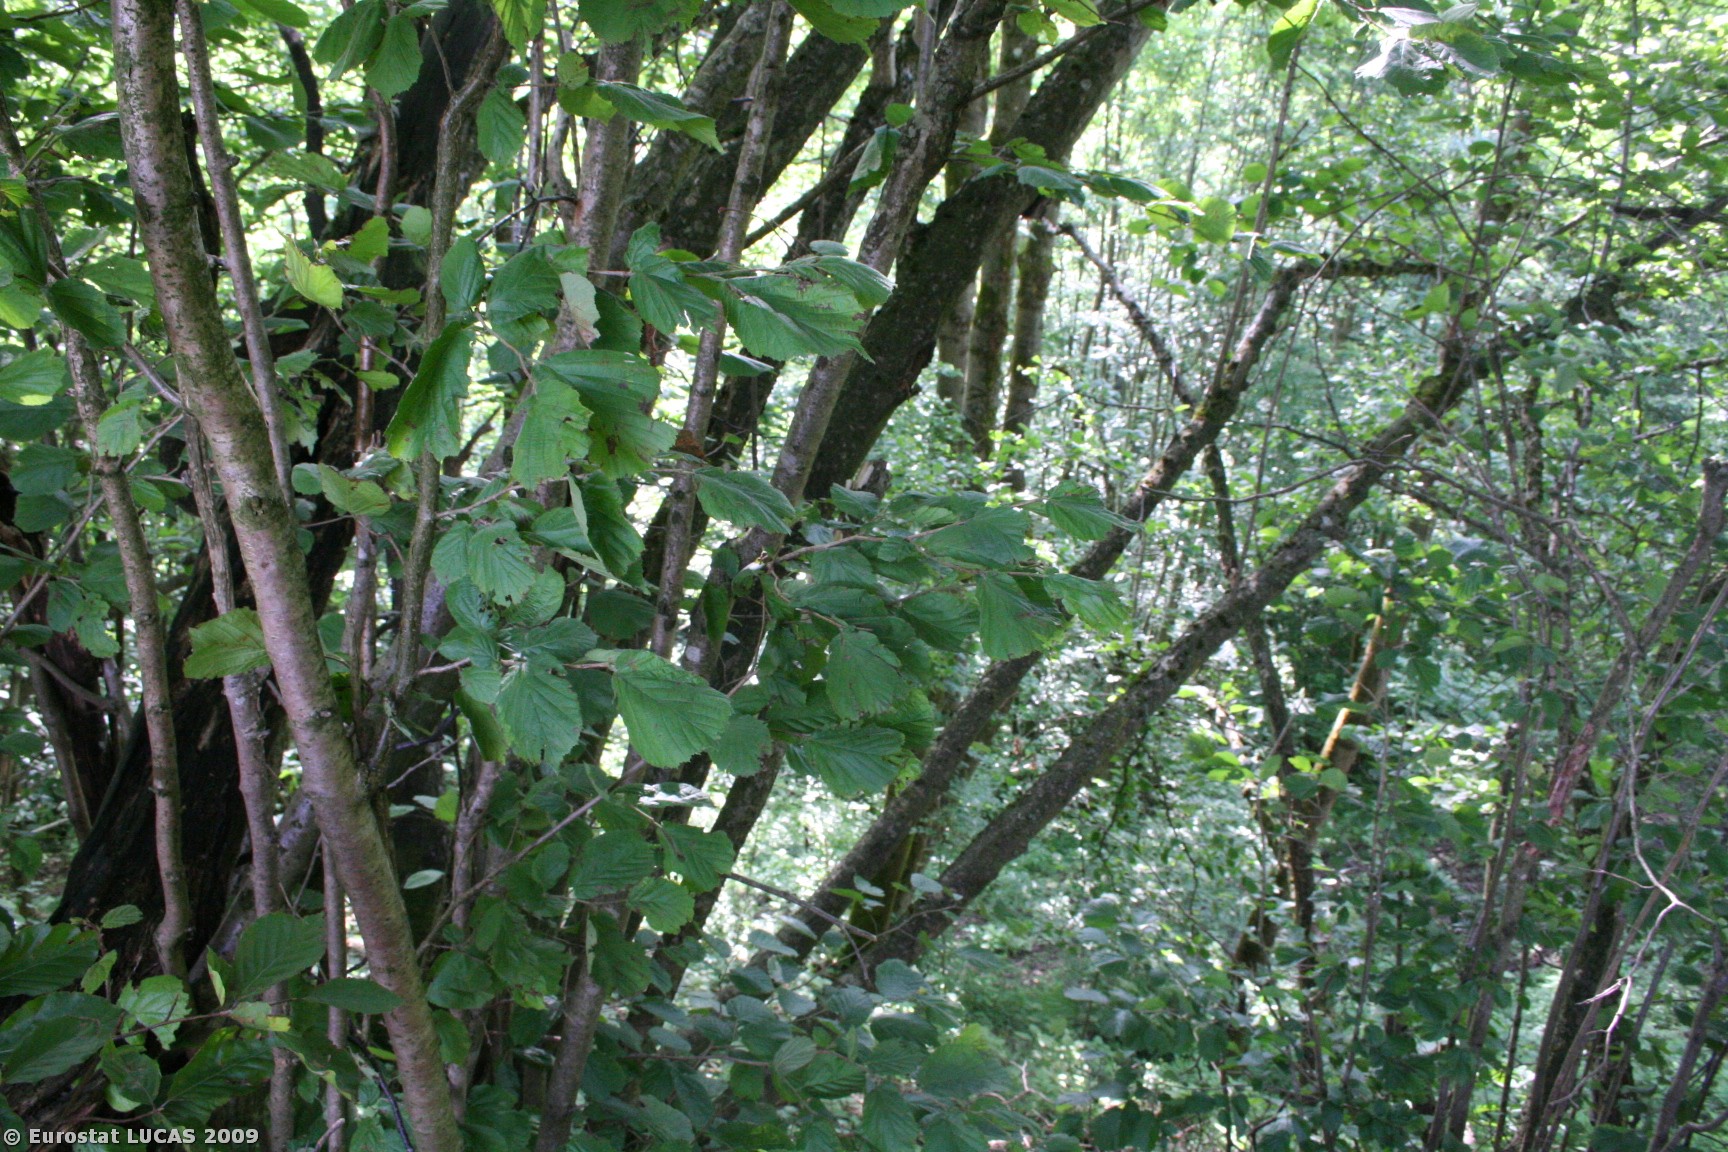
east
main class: Woodland
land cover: Broadleaved woodland
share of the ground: 50 - 75 %
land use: Forestry
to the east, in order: Broadleaved woodland; Coniferous woodland; Broadleaved woodland; Tracks; Shrubland with sparse tree cover; Electric lines; Shrubland with sparse tree cover; Grassland without tree/shrub cover
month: June
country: AT
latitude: 47.4568
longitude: 13.1950
